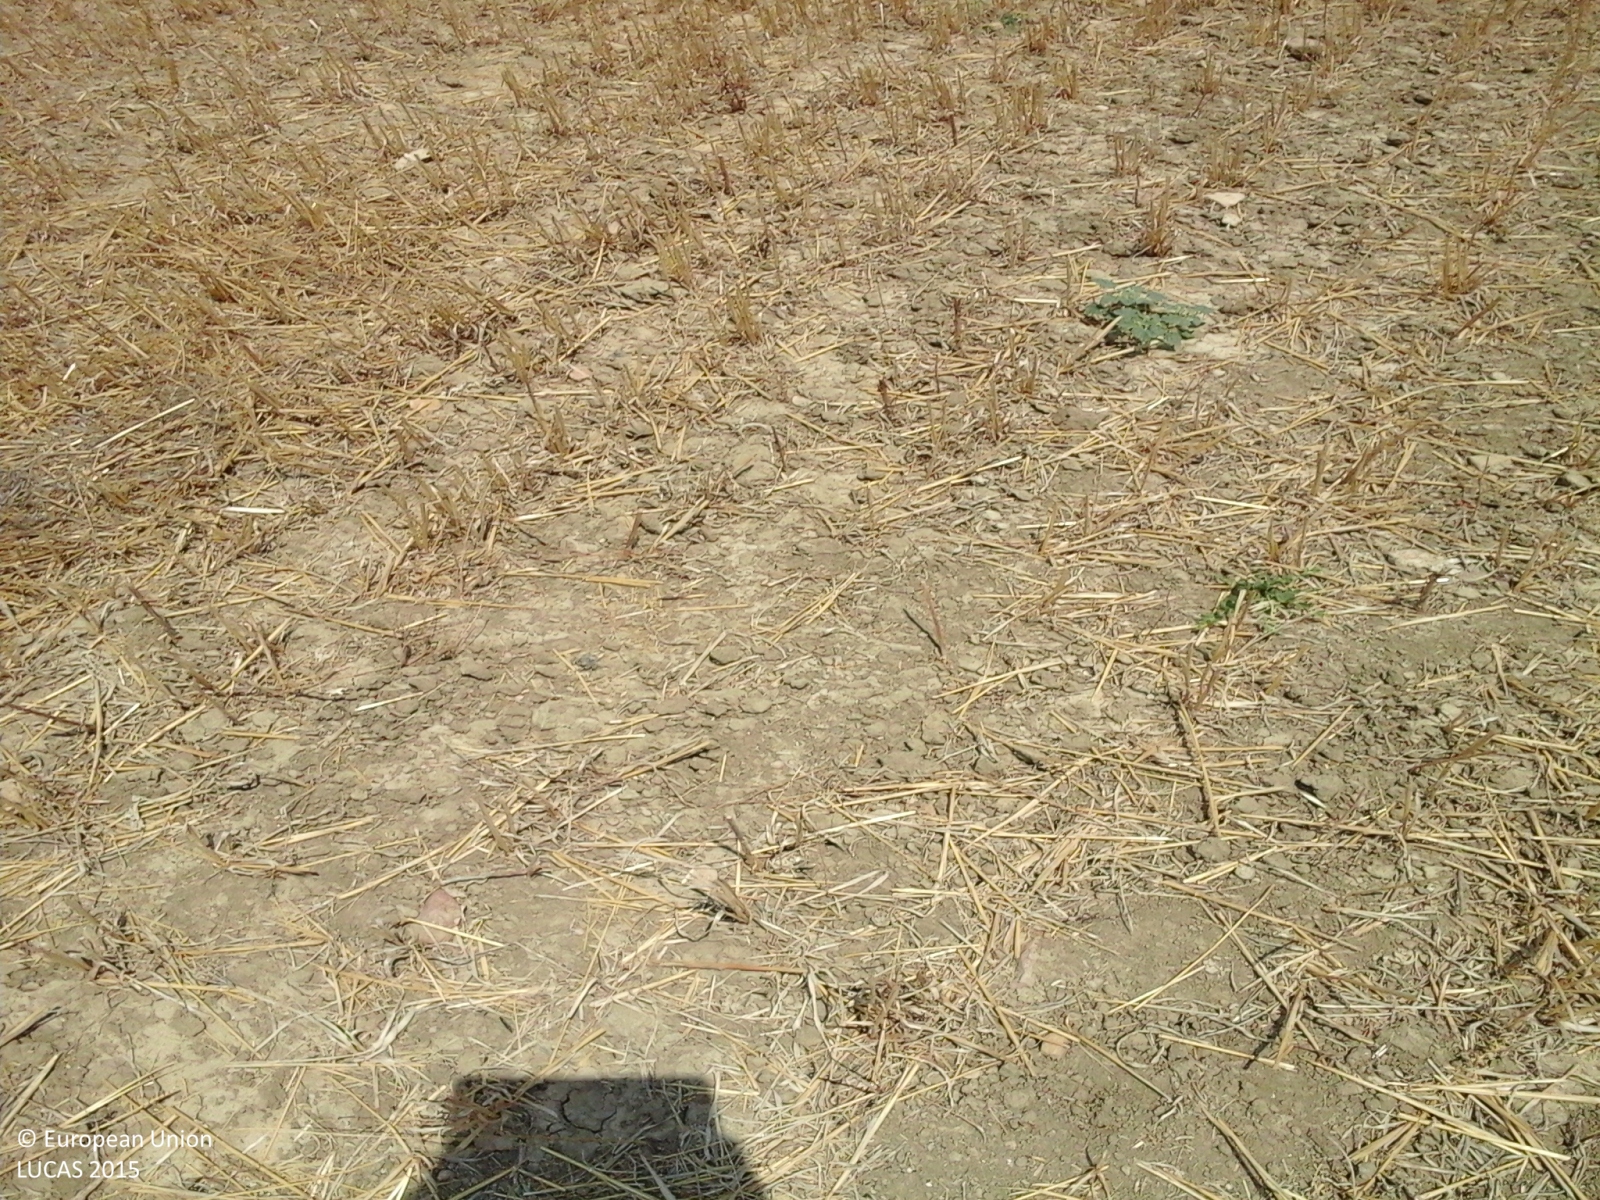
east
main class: Cropland
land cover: Durum wheat
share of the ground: > 75 %
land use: Agriculture (excluding fallow land and kitchen gardens)
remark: Burnt area
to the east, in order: Durum wheat; Electric lines; Durum wheat; Paved roads, cycling and walking lanes; Durum wheat; Shruby margins; Ditches and canals; Shruby margins; Durum wheat; Grassland without tree/shrub cover; Paved roads, cycling and walking lanes; Grass margins; Durum wheat
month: July
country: IT
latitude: 37.1562
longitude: 14.3687
